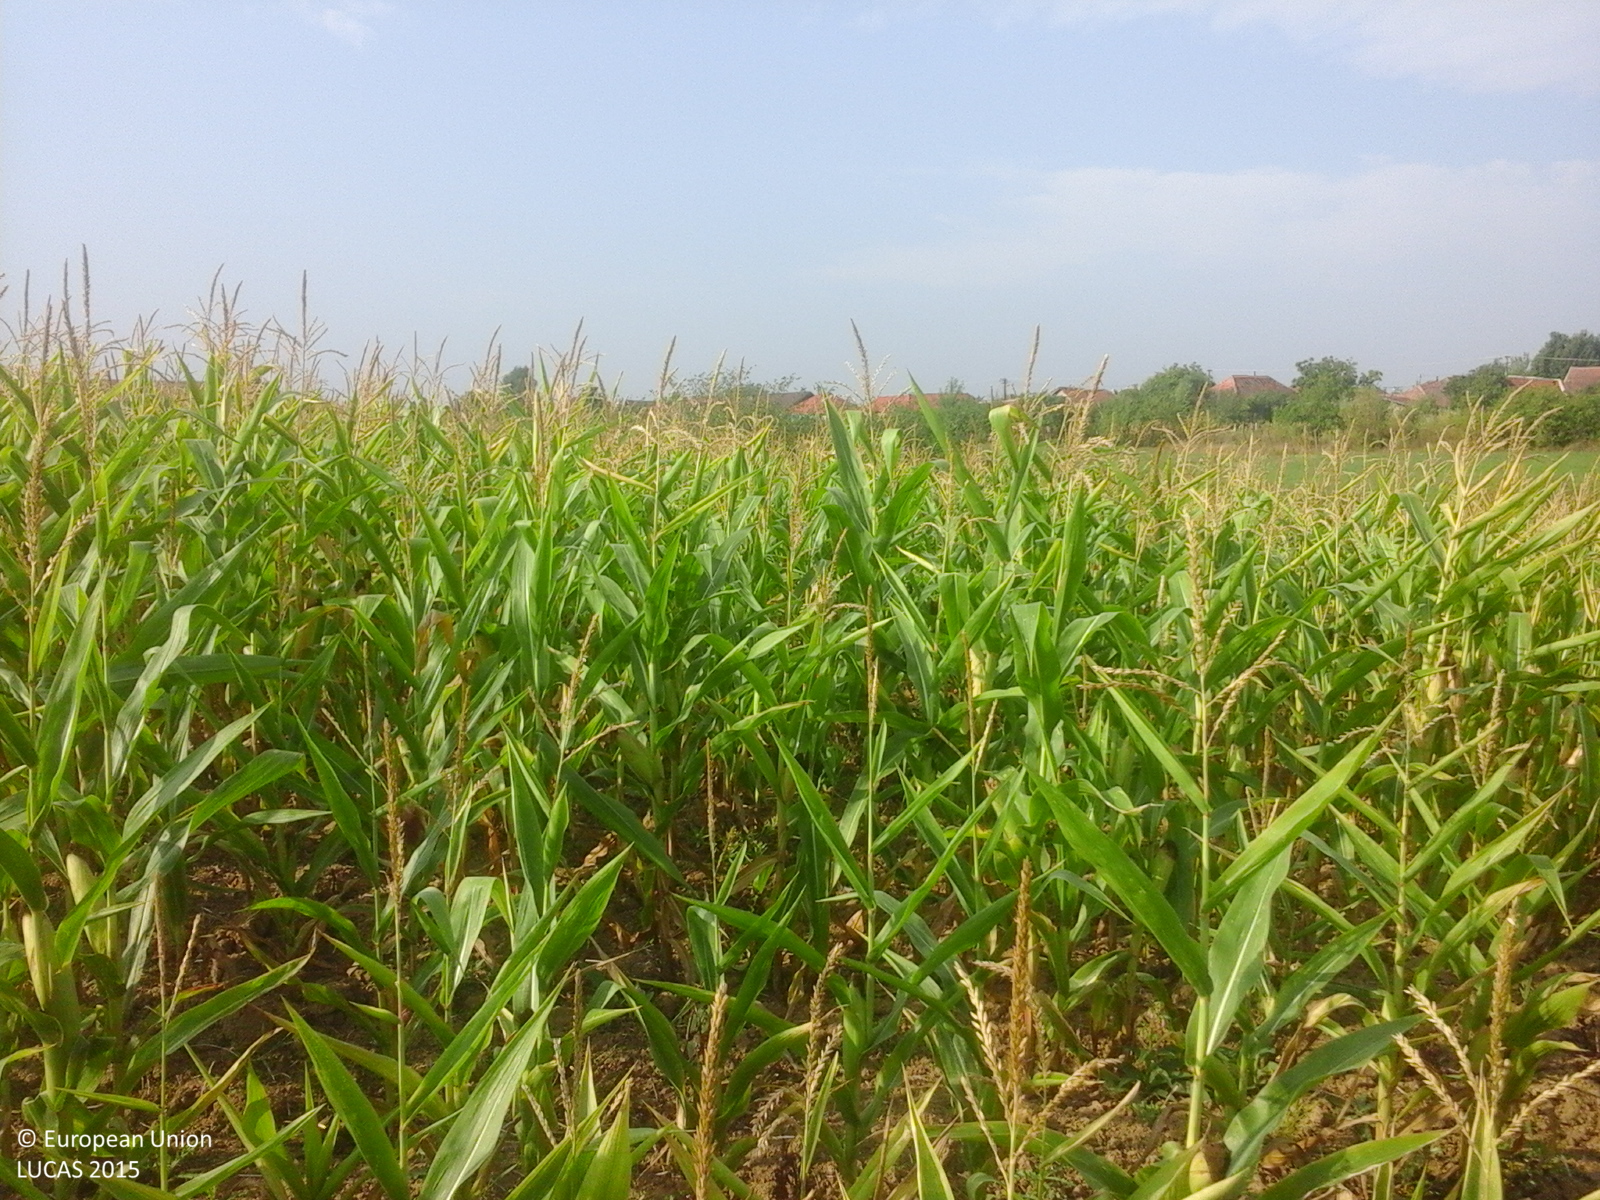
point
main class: Cropland
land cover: Maize
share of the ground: > 75 %
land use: Agriculture (excluding fallow land and kitchen gardens)
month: August
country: RO
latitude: 46.4248
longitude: 21.9495
